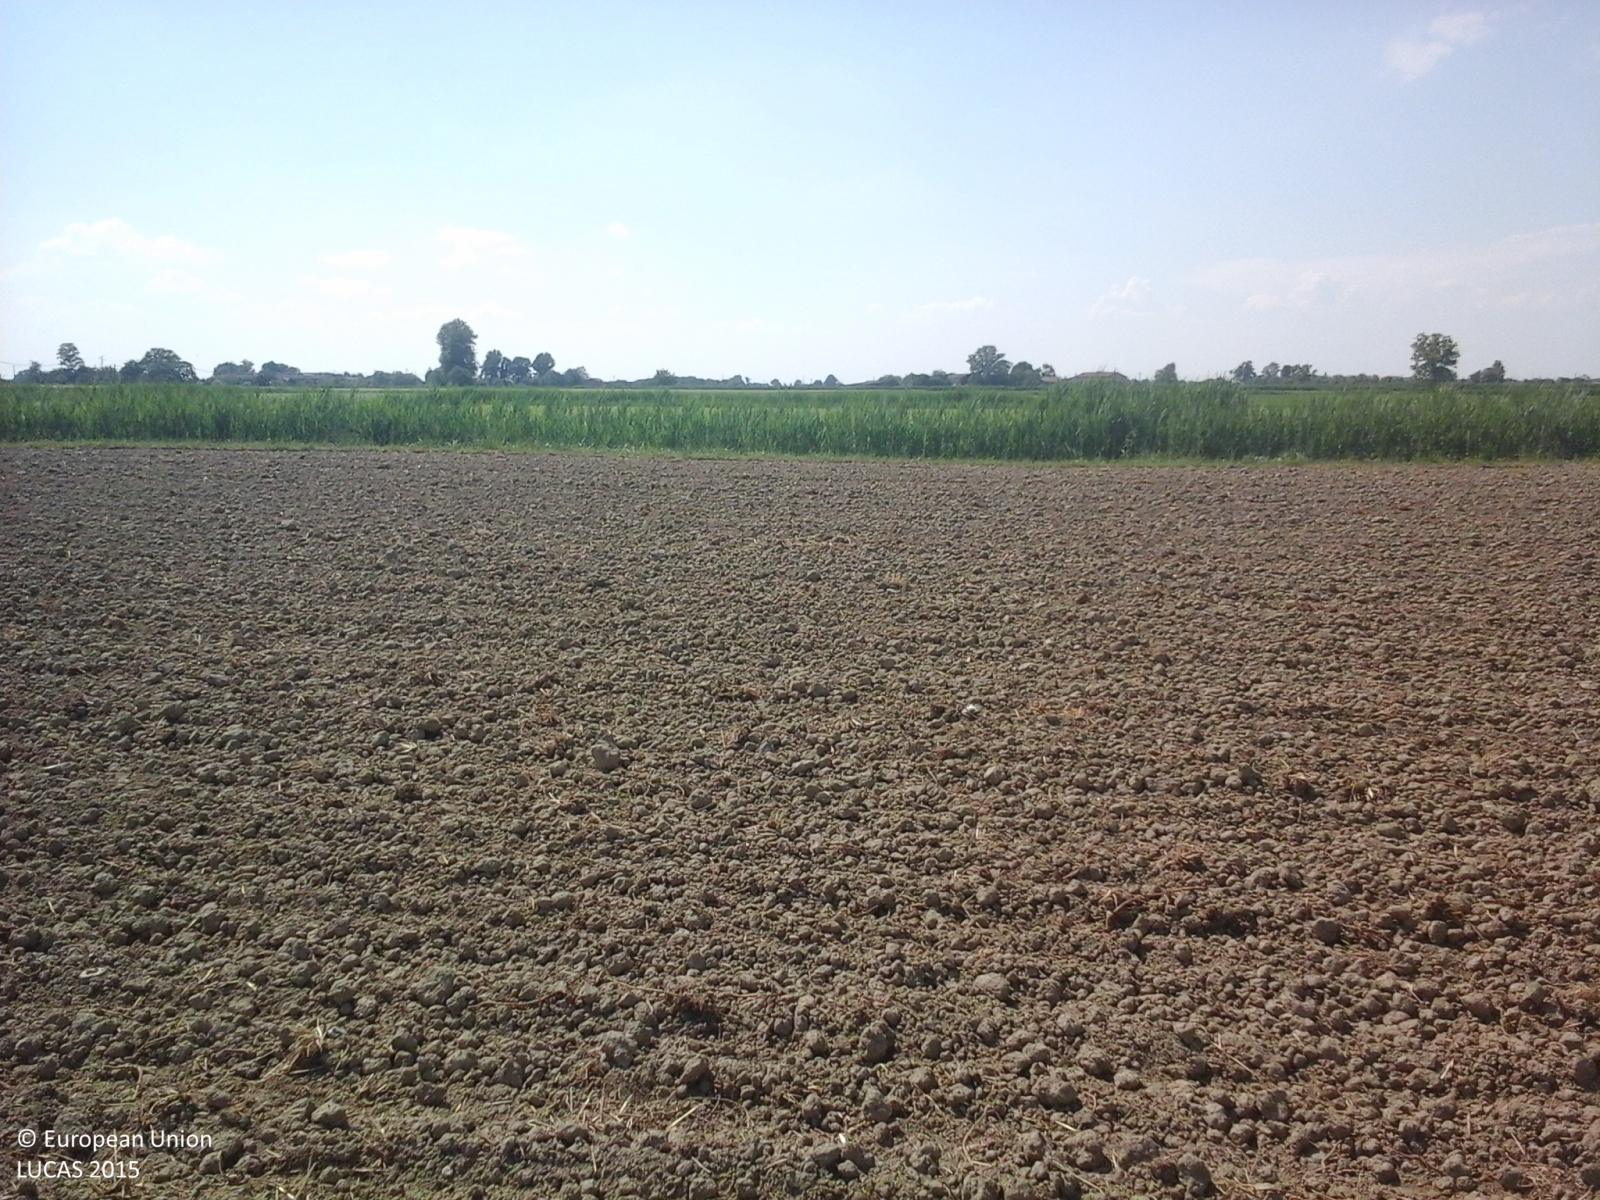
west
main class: Cropland
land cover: Maize
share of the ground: < 10 %
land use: Agriculture (excluding fallow land and kitchen gardens)
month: May
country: IT
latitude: 45.0858
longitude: 10.9257
